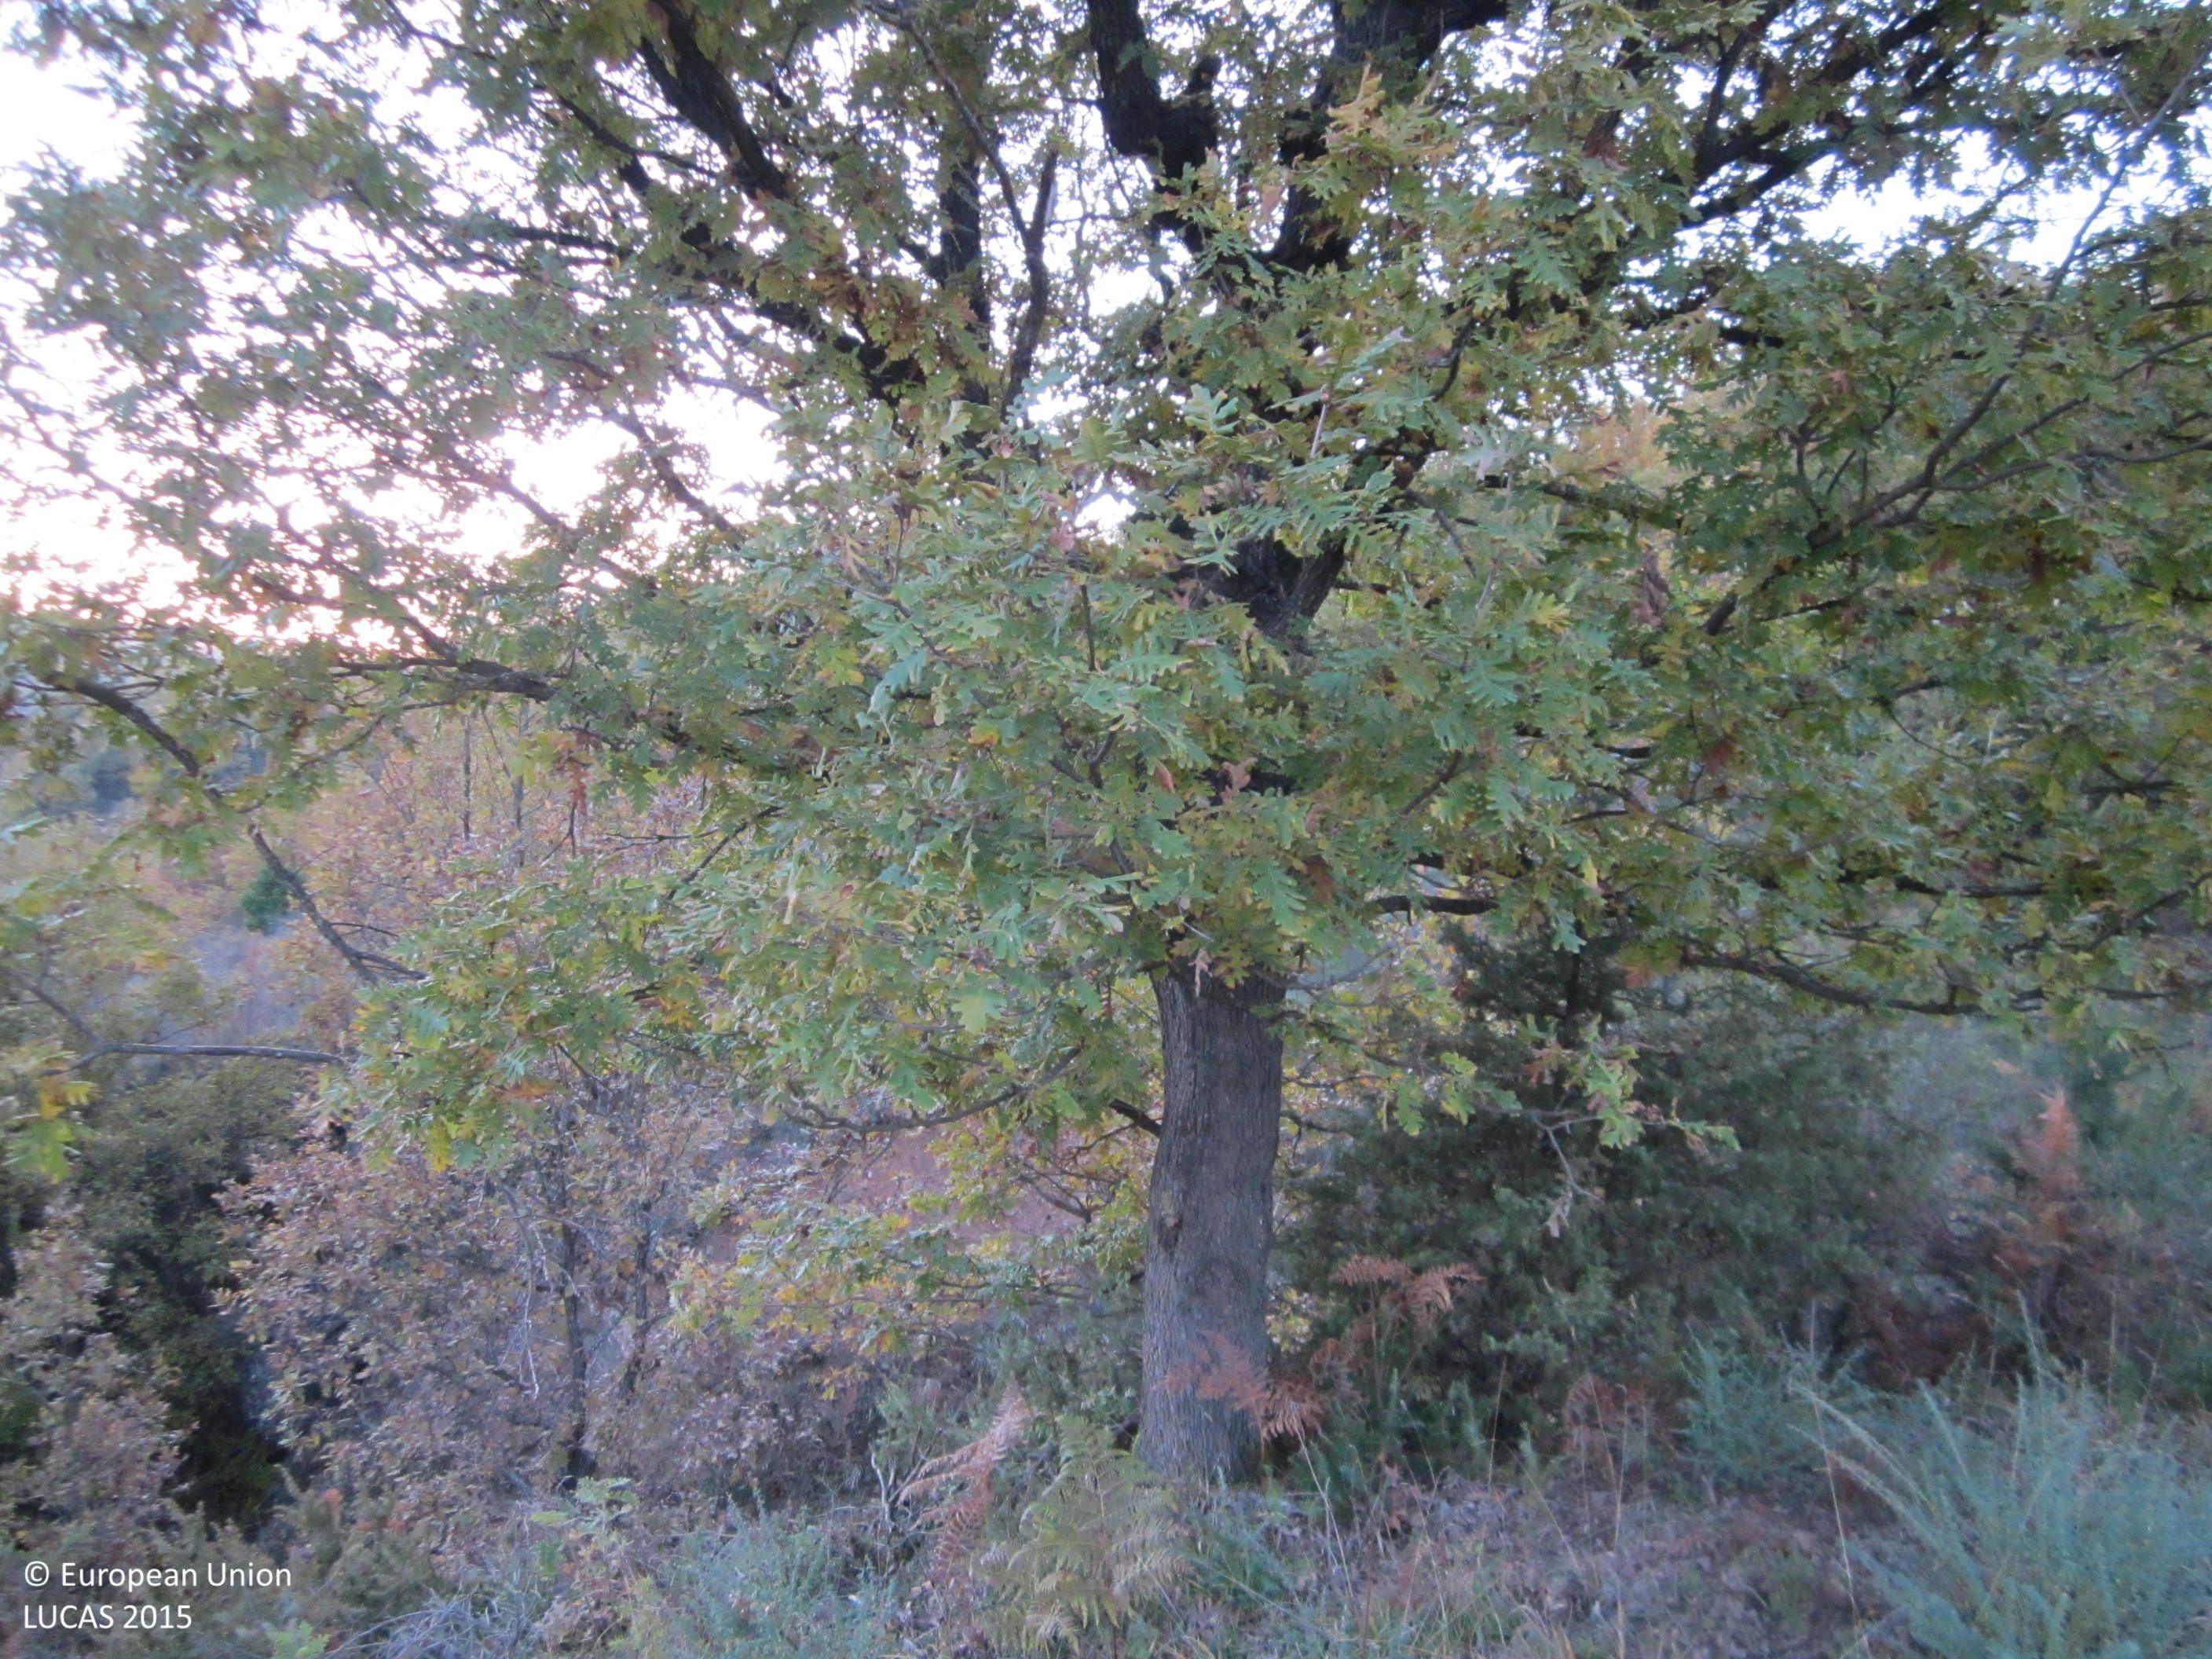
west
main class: Grassland
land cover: Grassland with sparse tree/shrub cover
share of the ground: > 75 %
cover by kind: herbaceous plants 85 %, shrubs 10 %, broadleaved forest trees 5 %
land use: Agriculture (excluding fallow land and kitchen gardens)
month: November
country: BG
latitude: 41.3782
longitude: 25.7364
